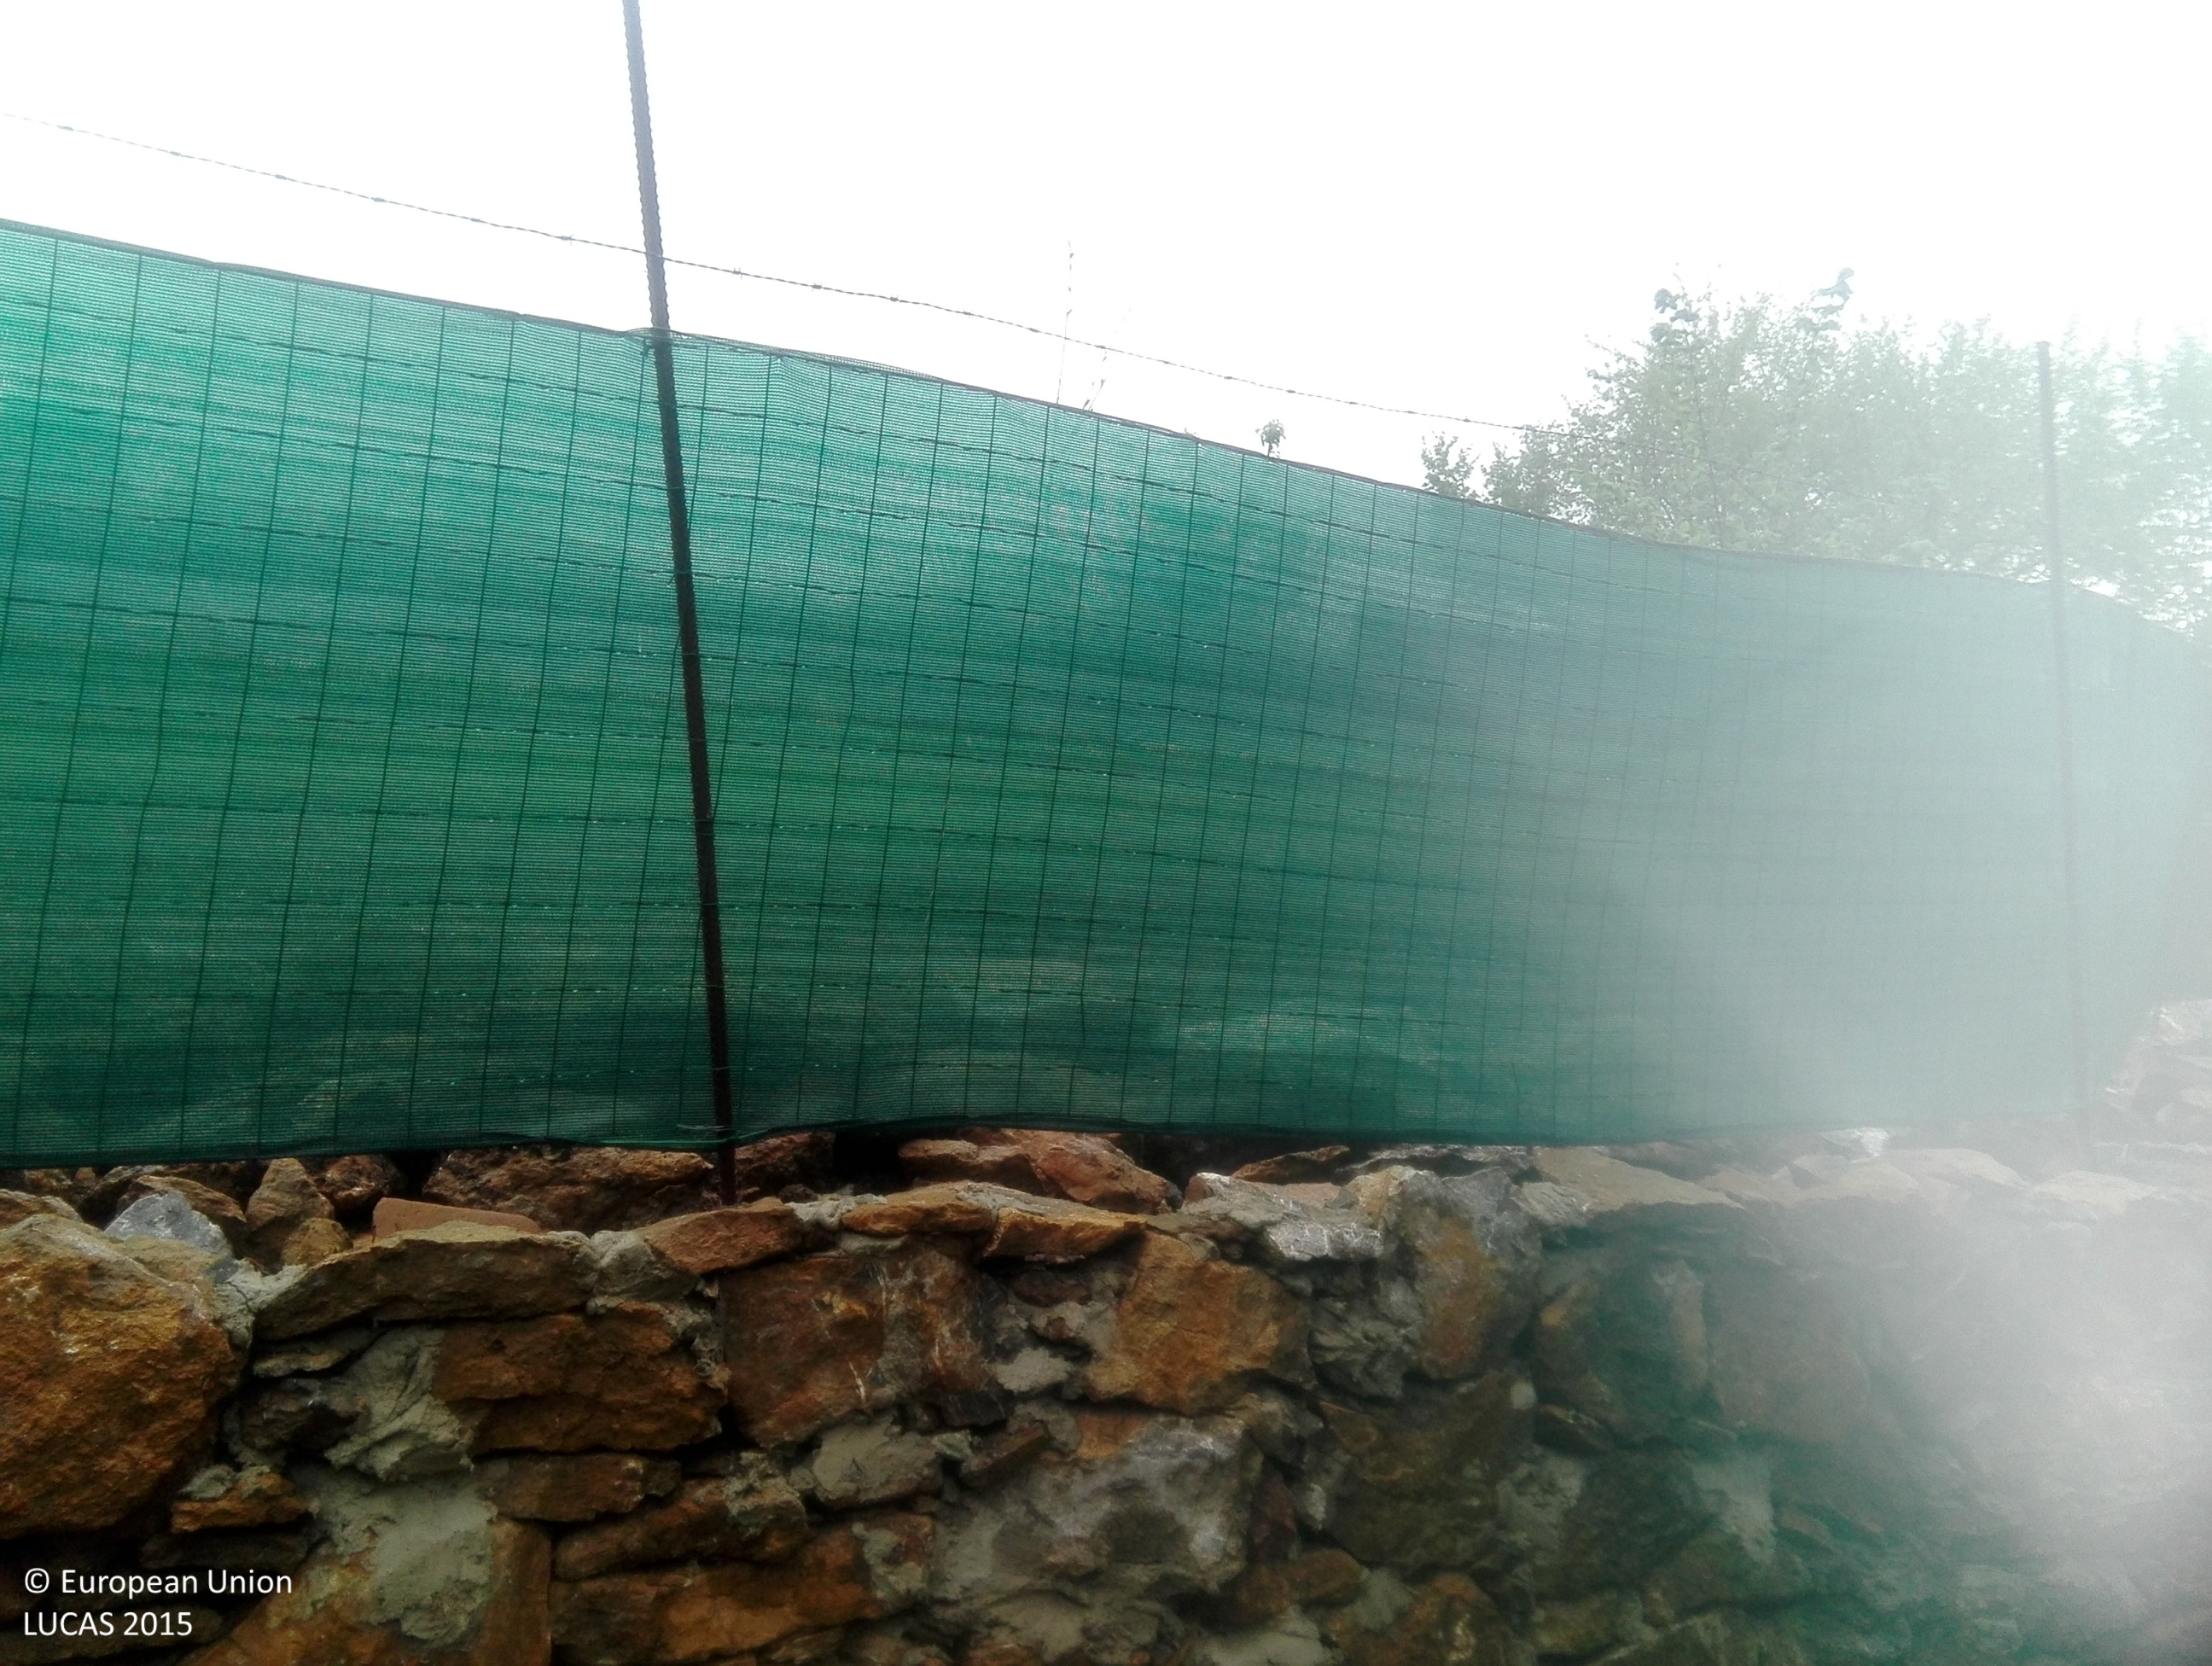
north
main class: Cropland
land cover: Apple fruit
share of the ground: 50 - 75 %
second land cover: Grassland without tree/shrub cover
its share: > 75 %
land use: Kitchen garden
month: April
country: ES
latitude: 43.3472
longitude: -5.9419
